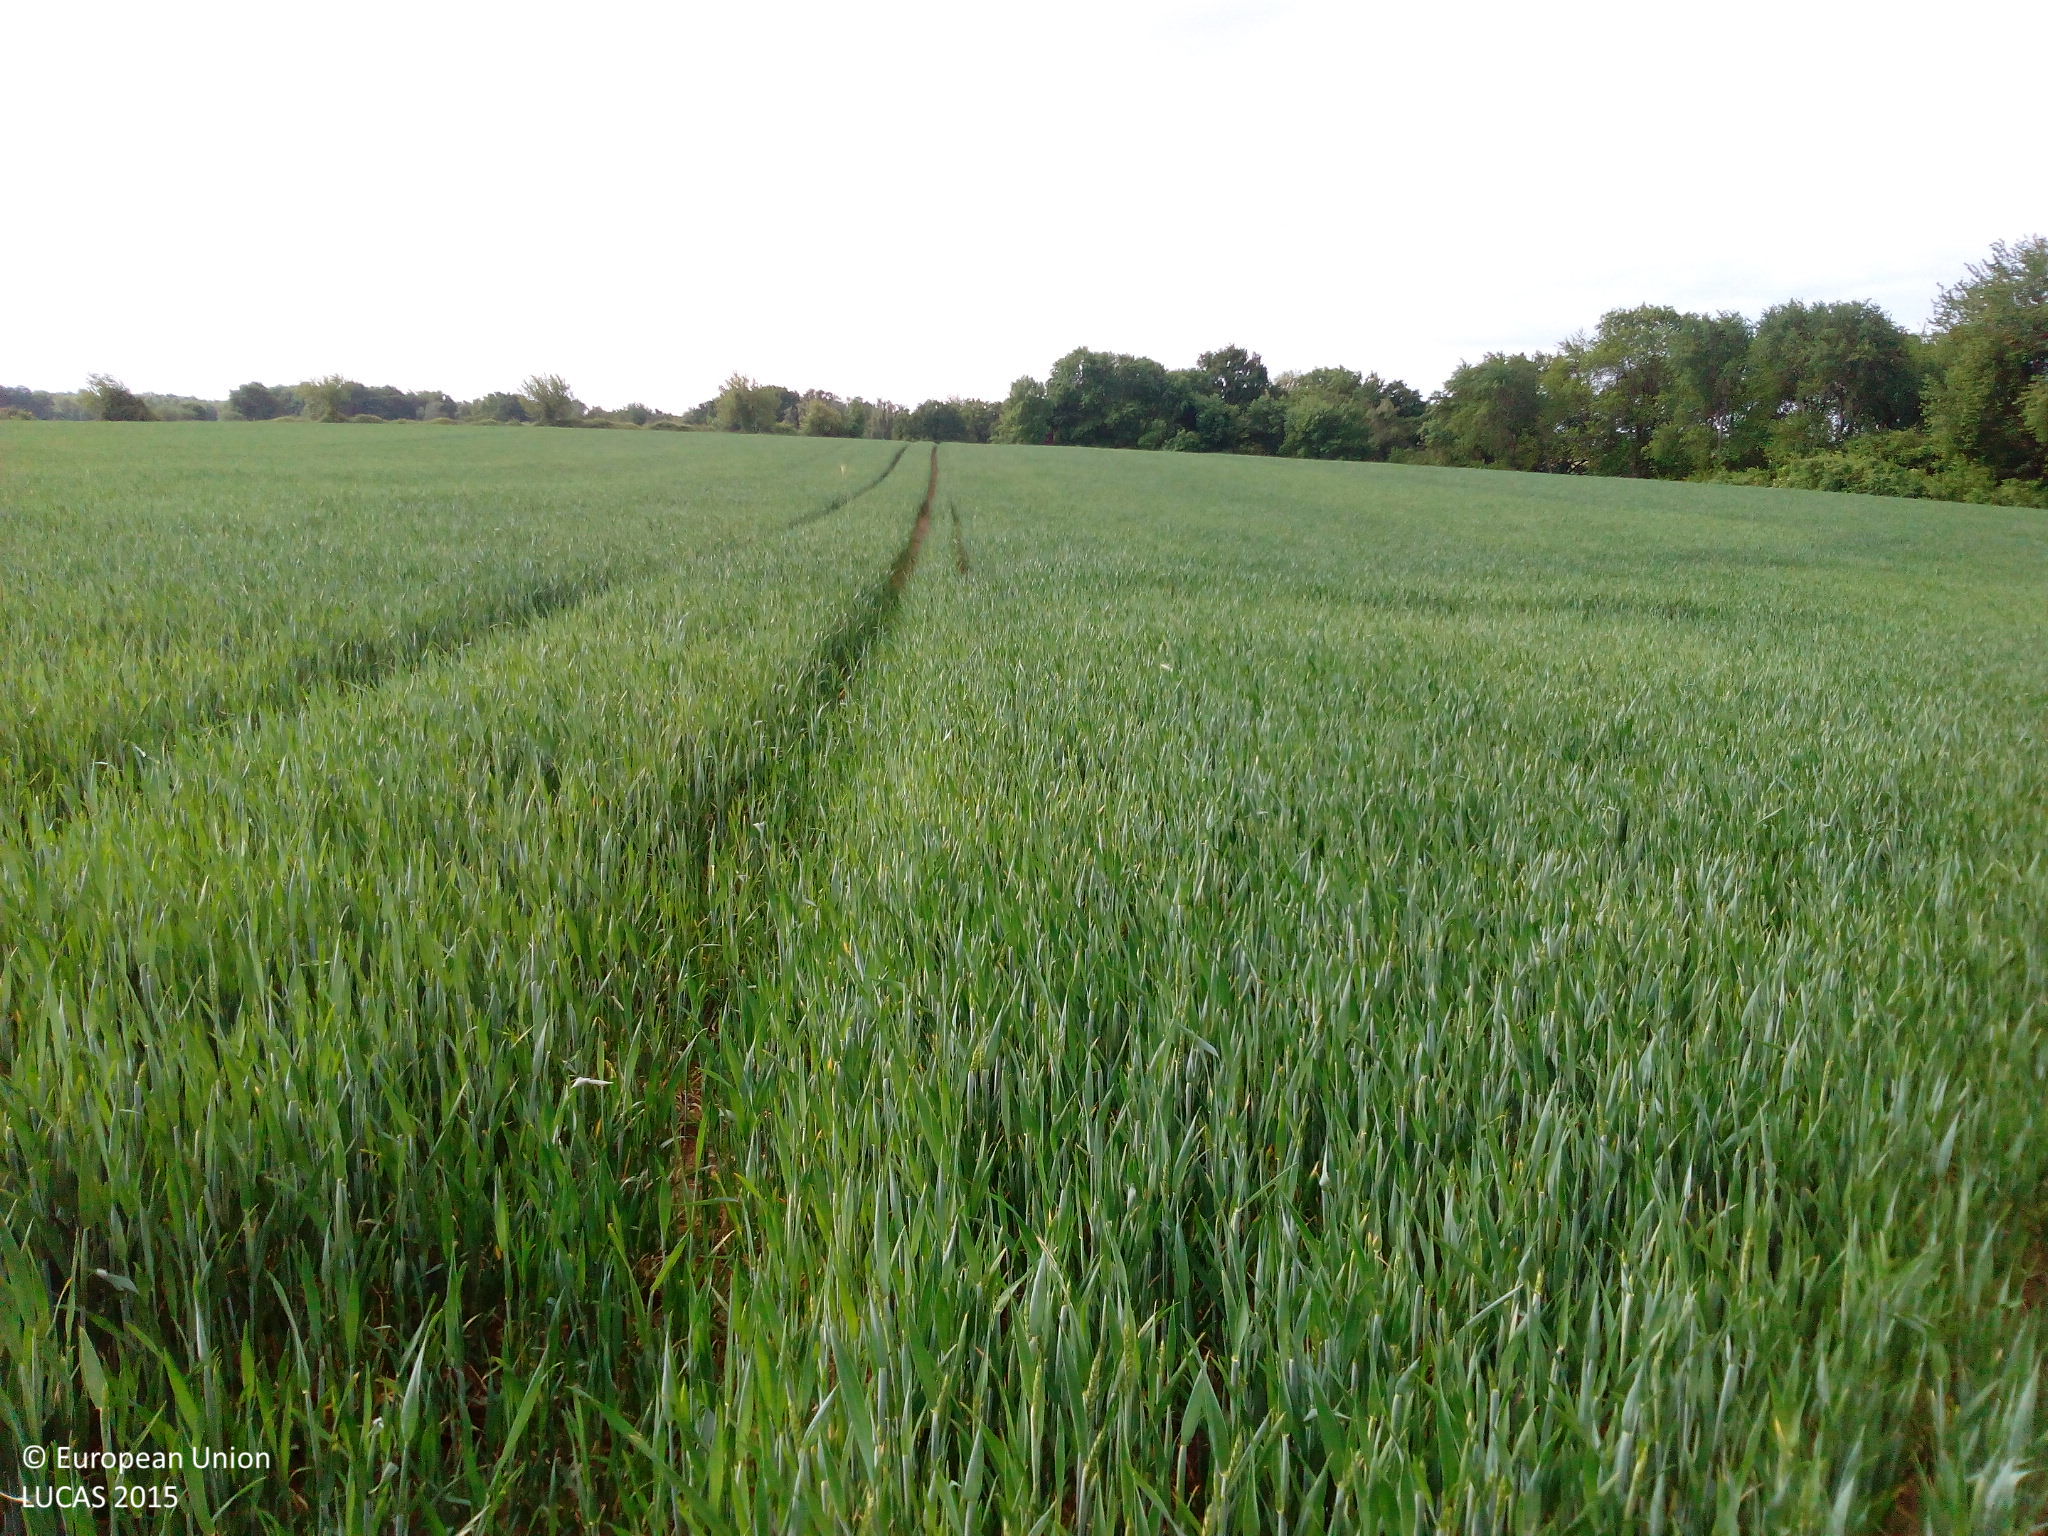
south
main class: Cropland
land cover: Common wheat
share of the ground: > 75 %
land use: Agriculture (excluding fallow land and kitchen gardens)
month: June
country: DE
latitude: 51.5340
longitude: 8.0253
